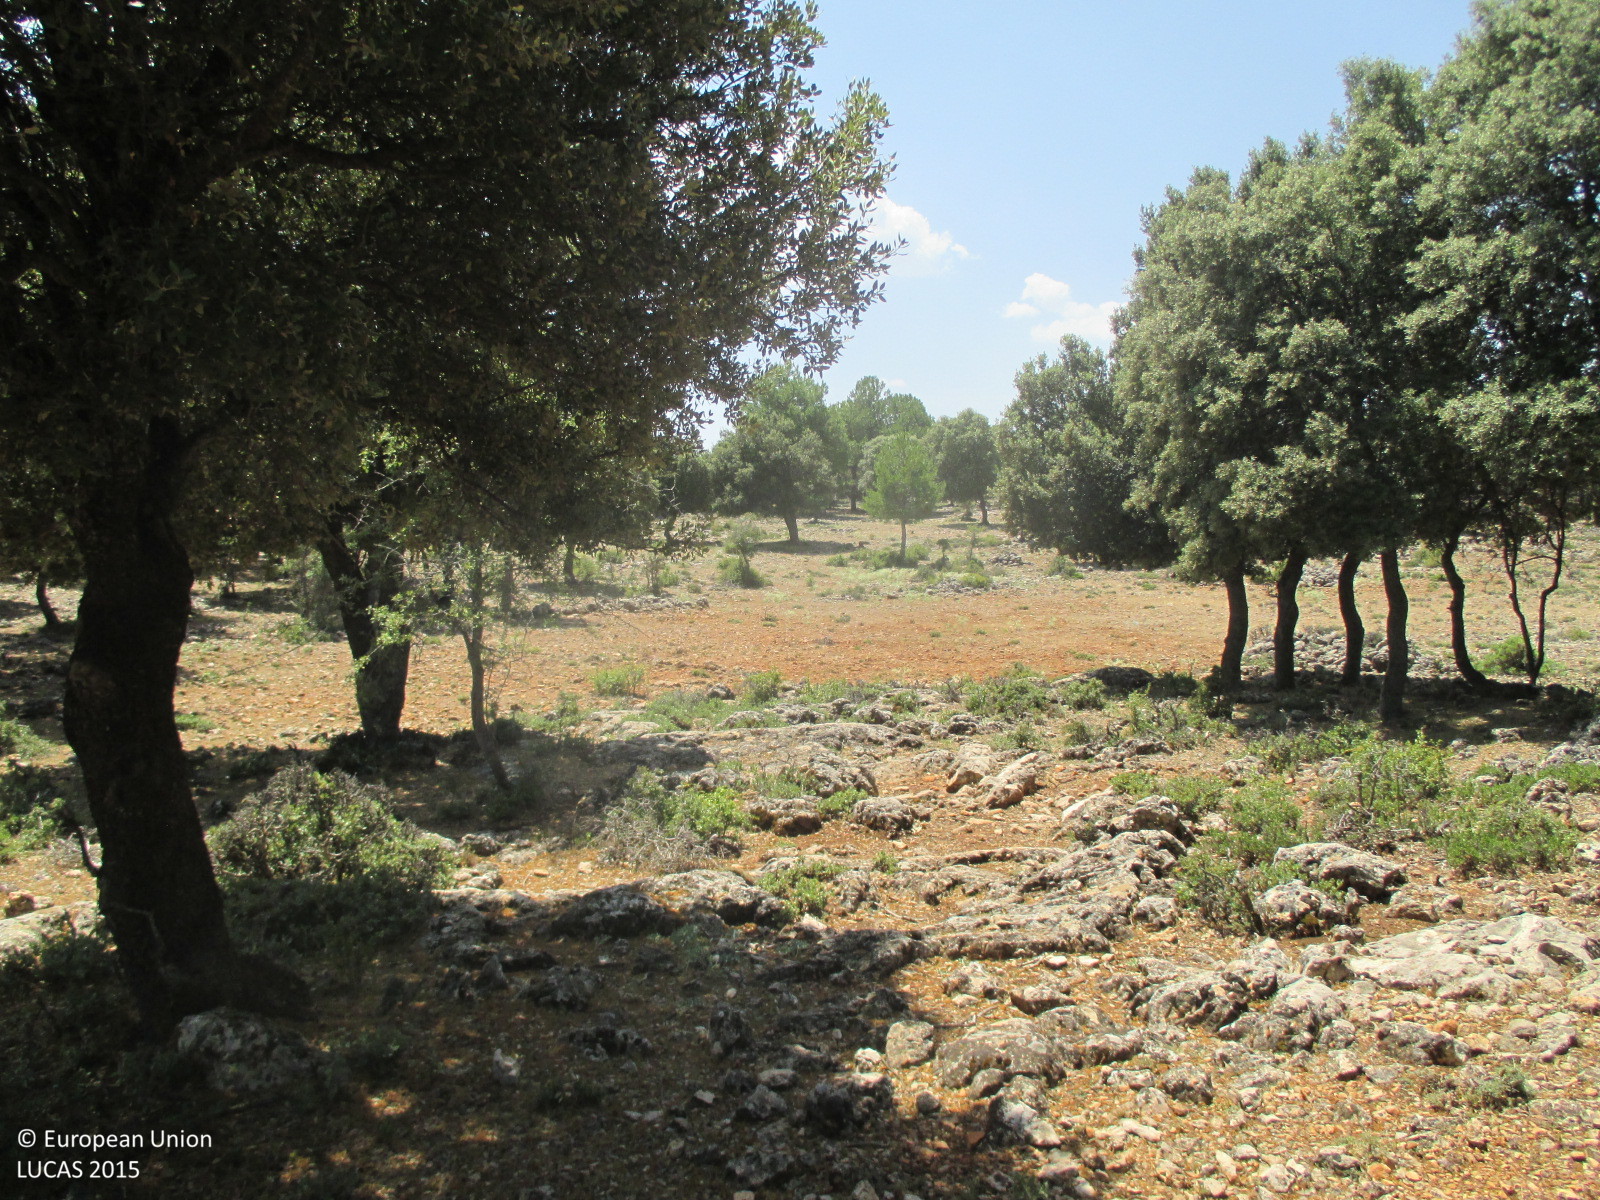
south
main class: Woodland
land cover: Broadleaved woodland
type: broadleaved evergreen forest
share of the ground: > 75 %
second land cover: Grassland without tree/shrub cover
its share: > 75 %
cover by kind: broadleaved forest trees 75 %, herbaceous plants 25 %
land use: Forestry
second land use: Agriculture (excluding fallow land and kitchen gardens)
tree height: > 5 m
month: July
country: ES
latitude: 38.0887
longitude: -2.5242
